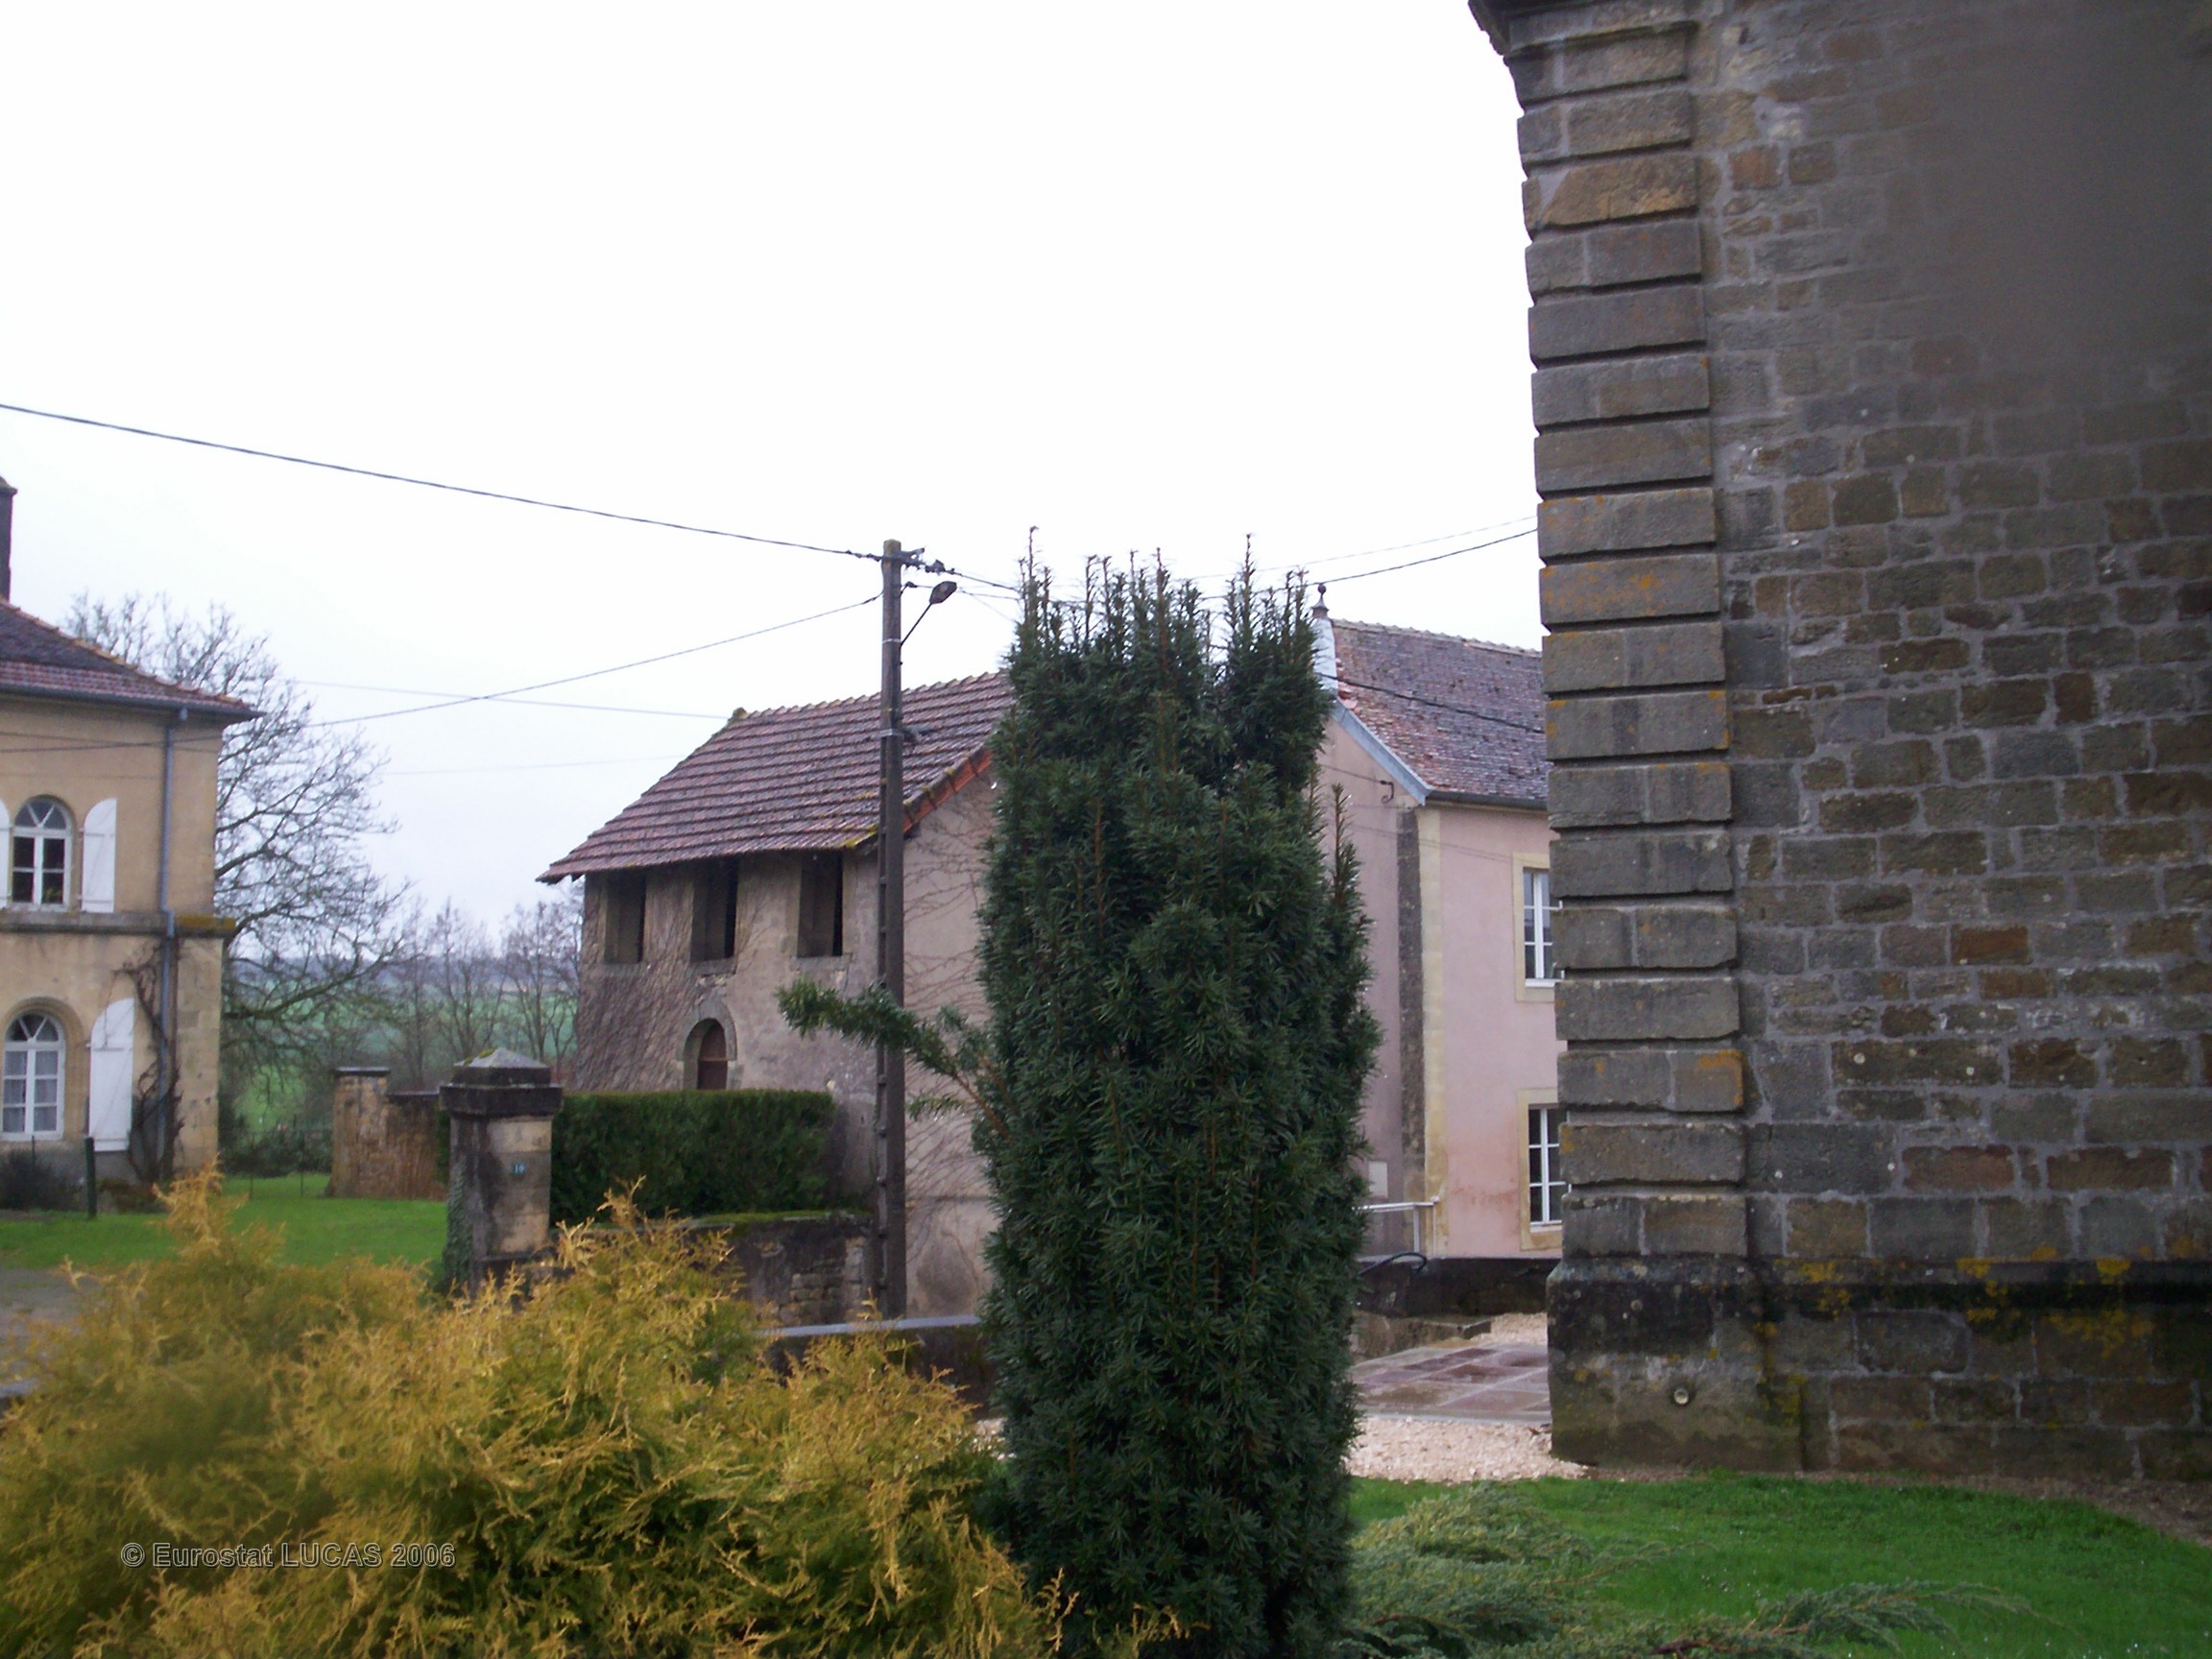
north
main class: Grassland
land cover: Grassland with sparse tree/shrub cover
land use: Community services
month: April
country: FR
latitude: 47.8289
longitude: 6.0601
